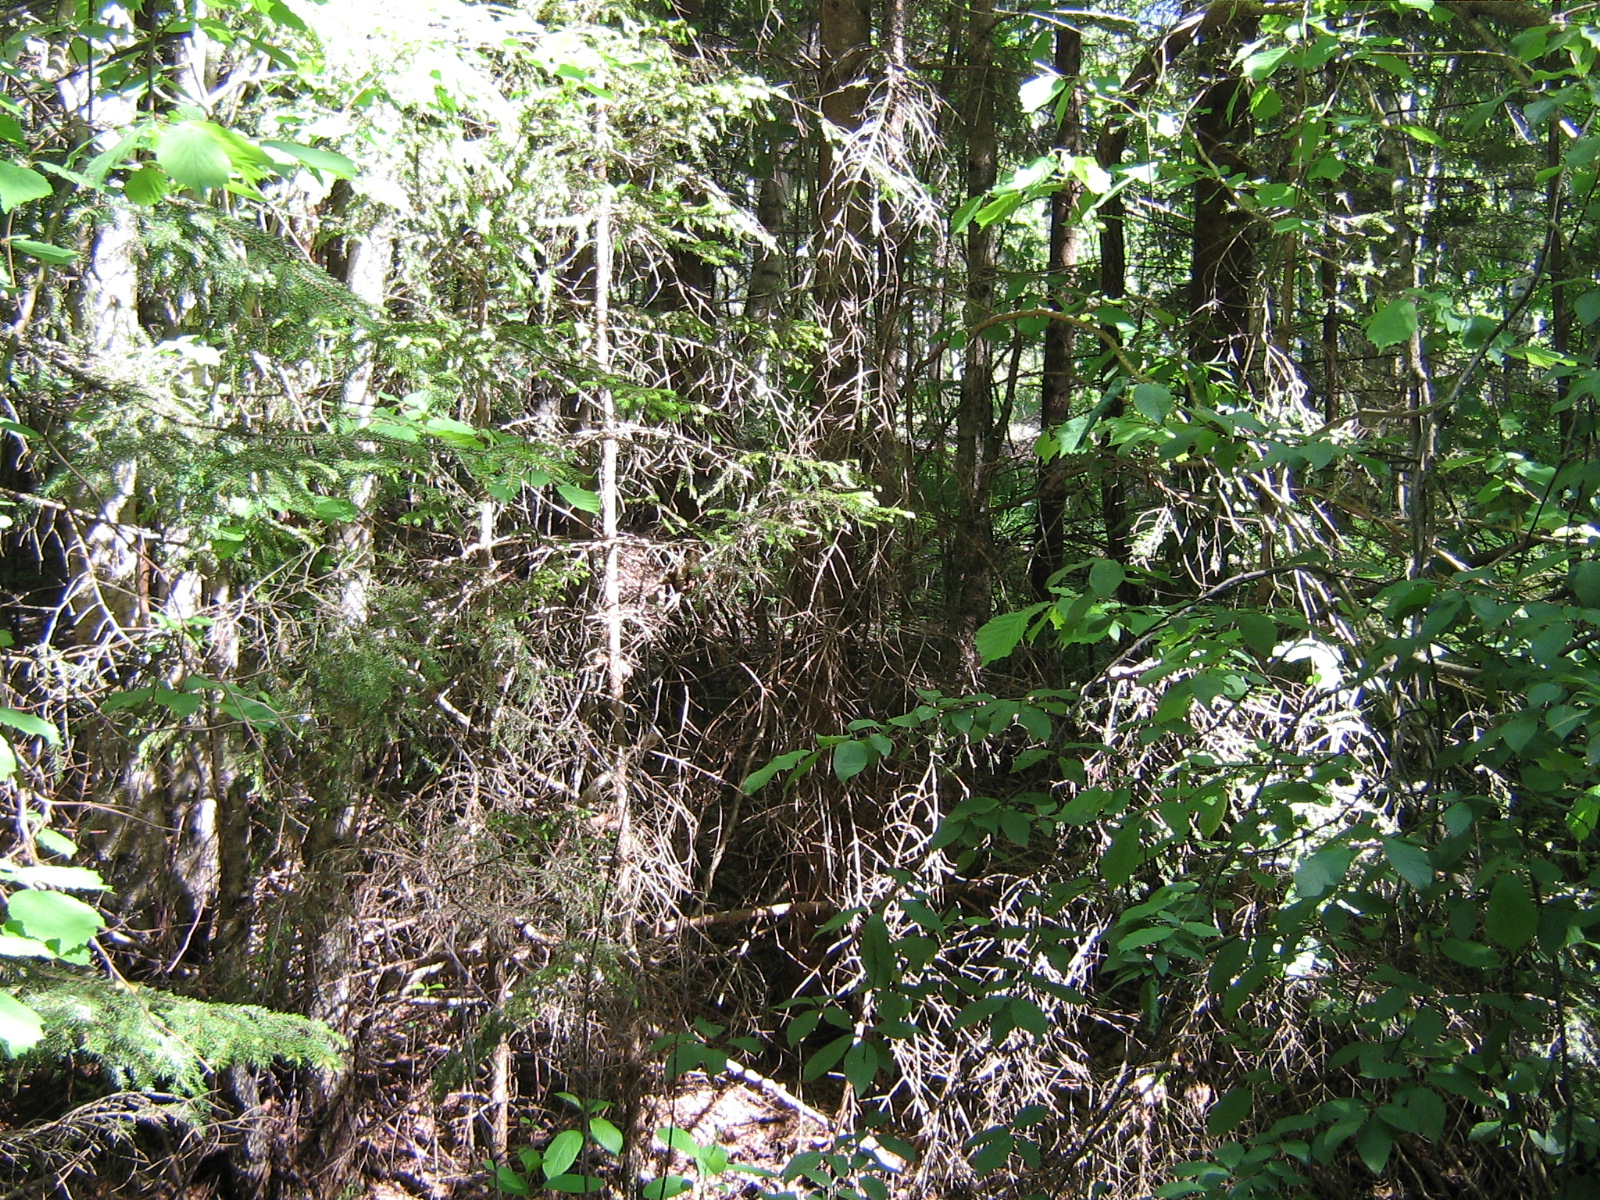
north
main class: Woodland
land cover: Spruce dominated mixed woodland
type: hemiboreal forest and nemoral coniferous forest and mixed broadleaved-coniferous forest
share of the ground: > 75 %
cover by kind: coniferous forest trees 60 %, broadleaved forest trees 40 %
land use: Forestry
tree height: > 5 m
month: June
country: LV
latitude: 57.0777
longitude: 25.9161
